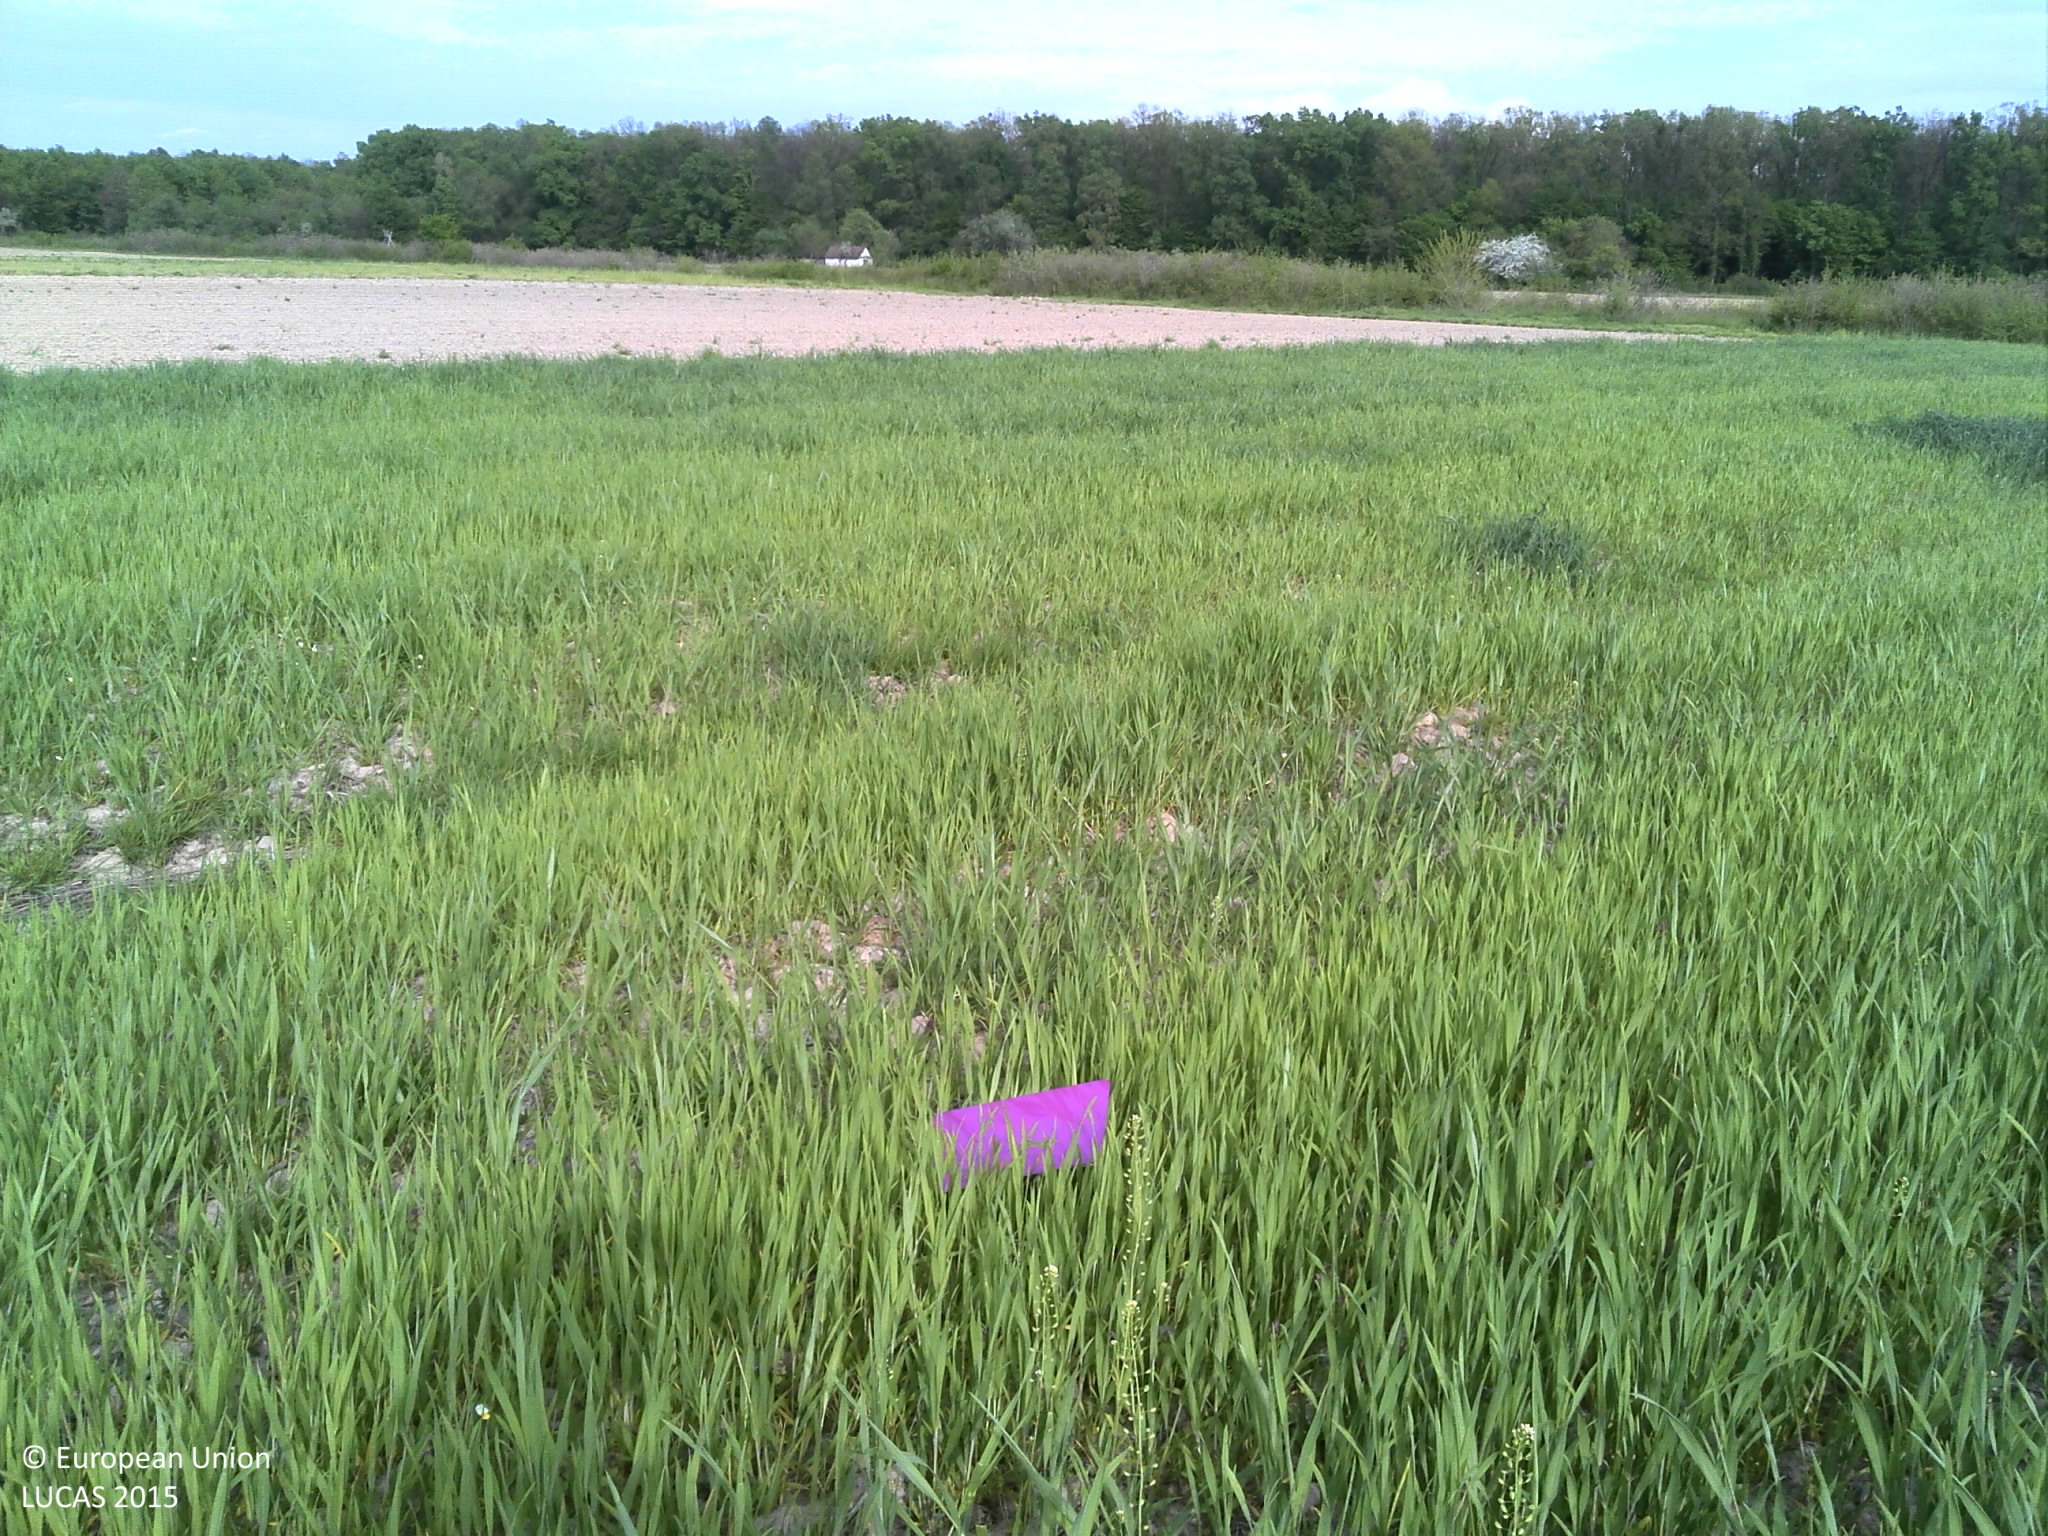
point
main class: Cropland
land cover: Common wheat
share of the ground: > 75 %
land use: Agriculture (excluding fallow land and kitchen gardens)
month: April
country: HR
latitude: 45.0633
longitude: 18.8072
